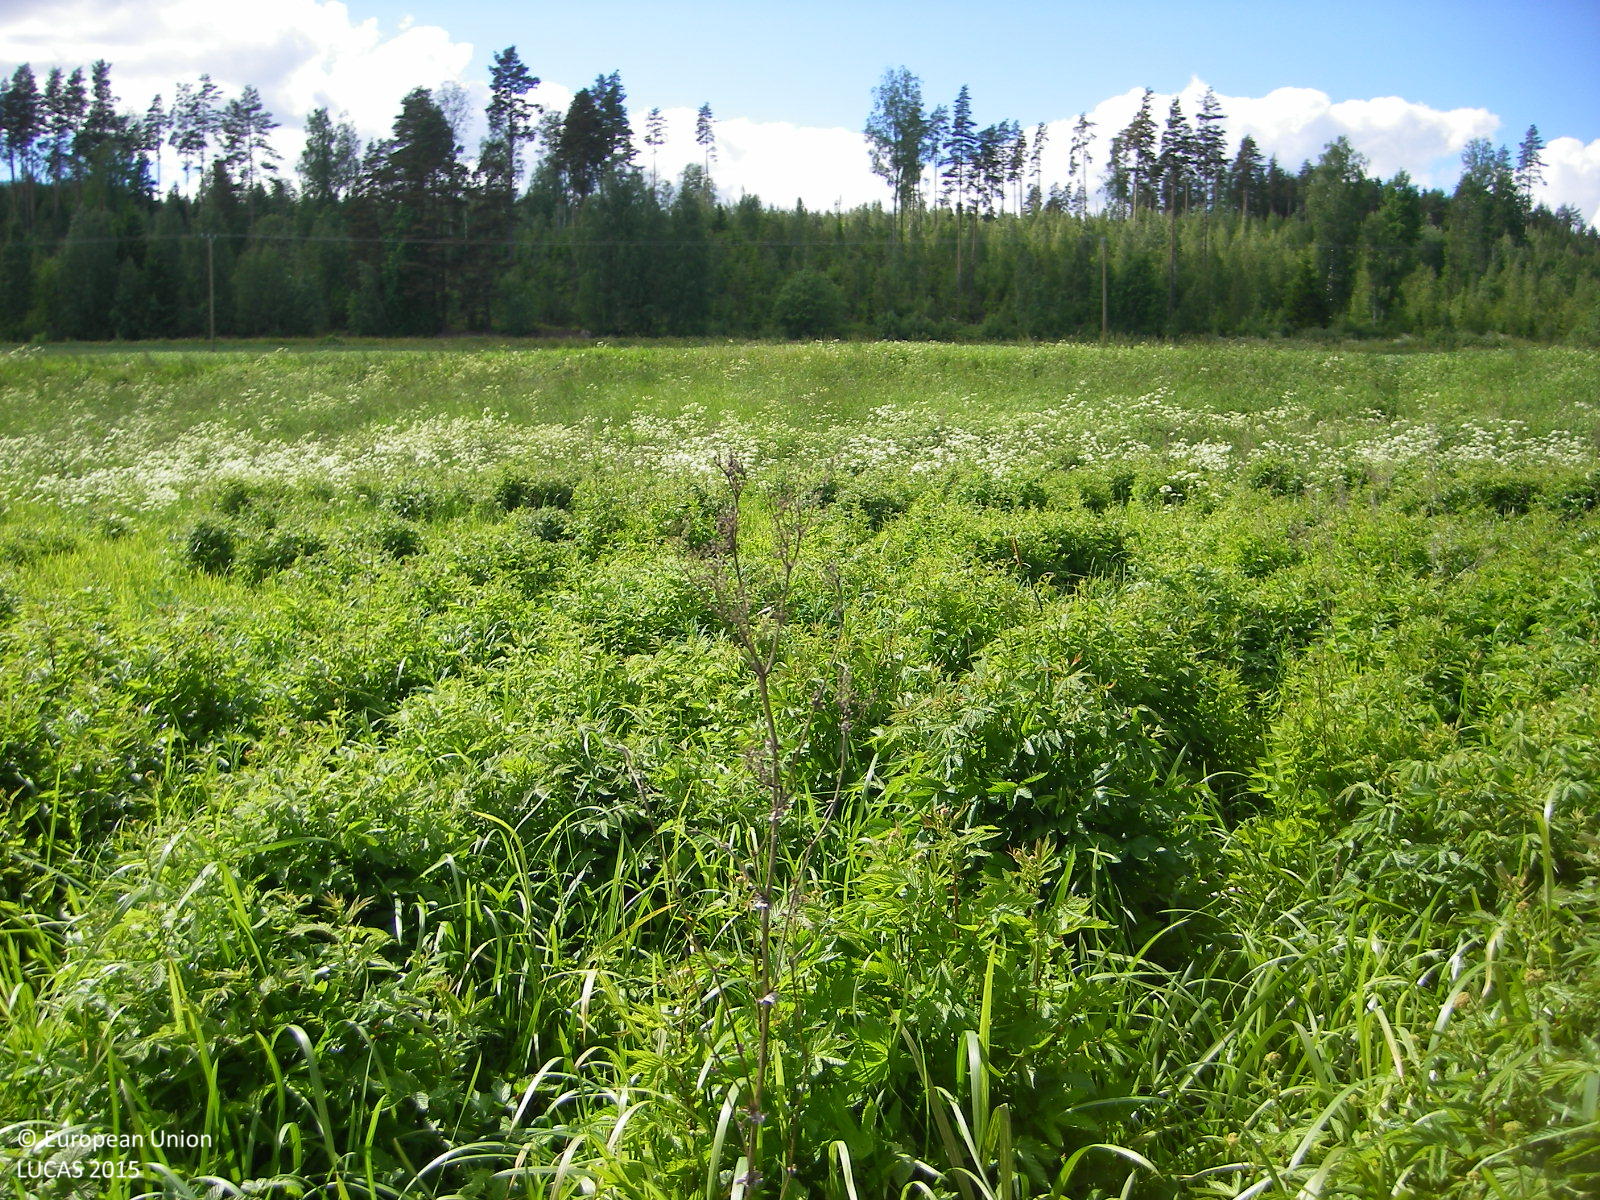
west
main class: Grassland
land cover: Spontaneously vegetated surfaces
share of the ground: > 75 %
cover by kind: herbaceous plants 100 %
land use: Semi-natural and natural areas not in use
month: June
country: FI
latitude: 60.3432
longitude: 24.1416
